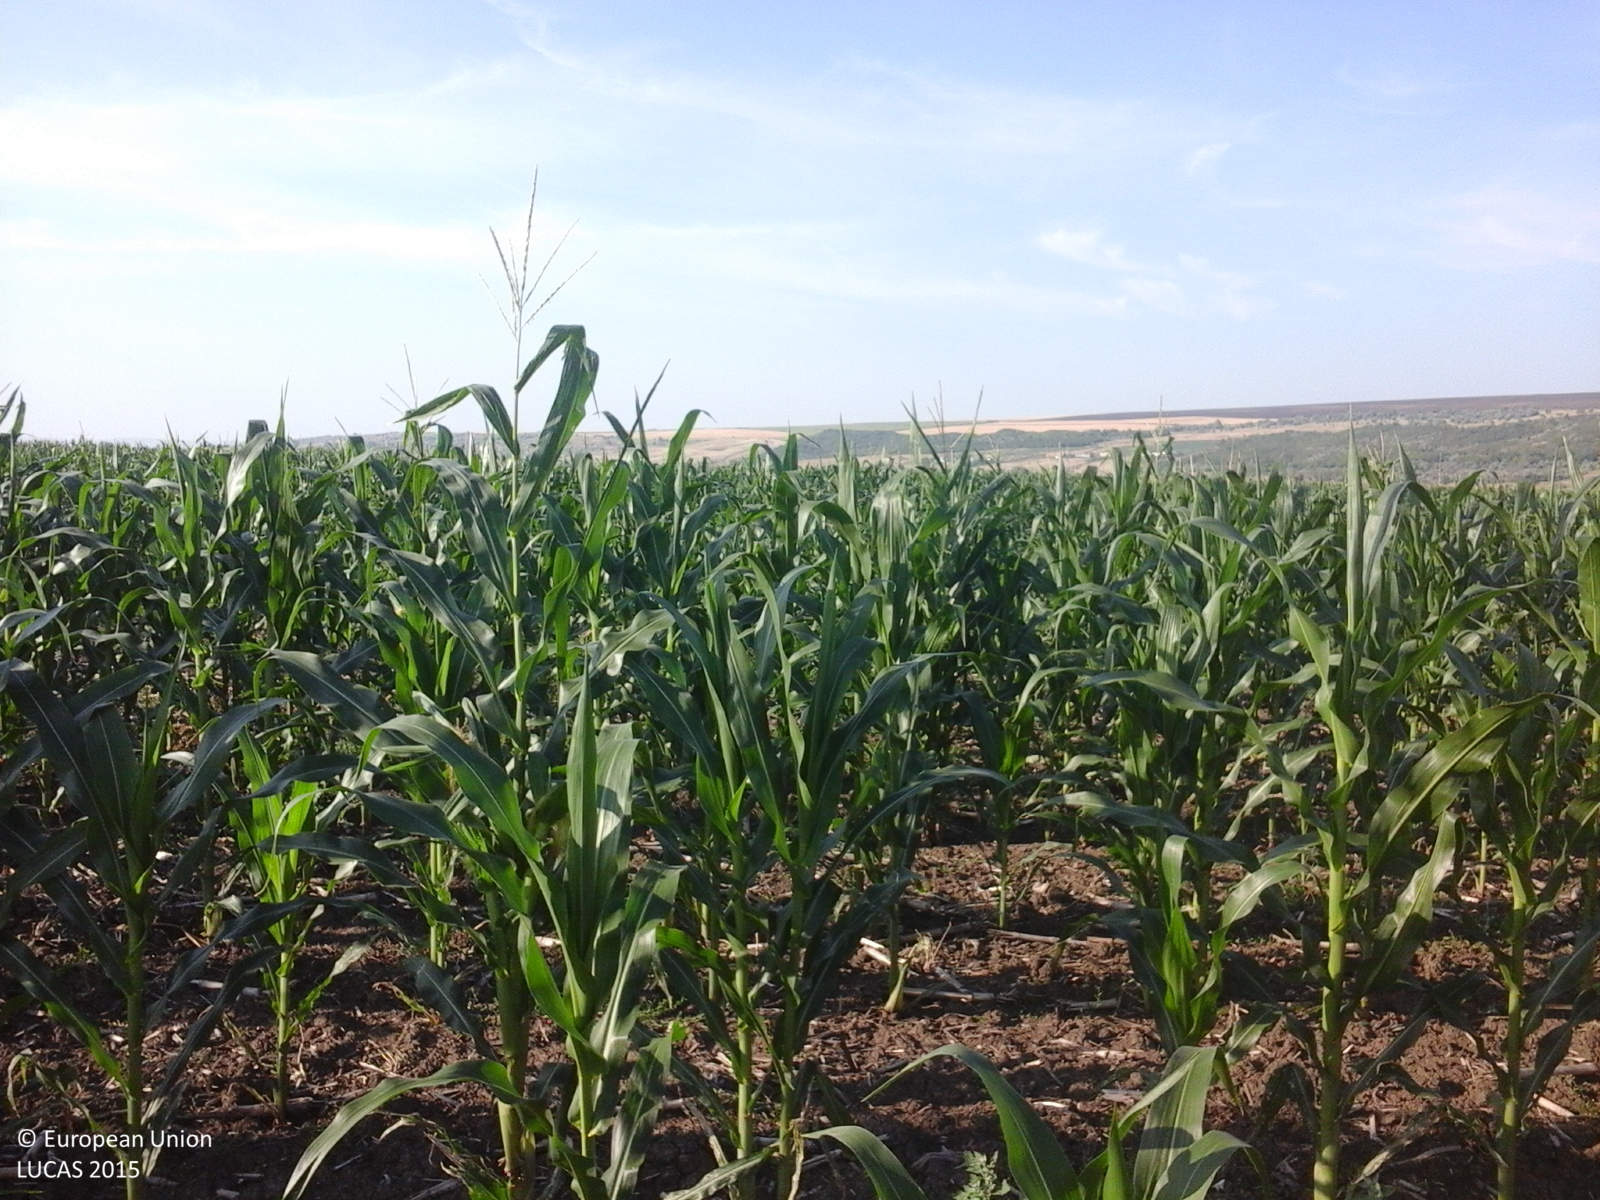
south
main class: Cropland
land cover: Maize
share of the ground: 50 - 75 %
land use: Agriculture (excluding fallow land and kitchen gardens)
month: July
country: RO
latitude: 46.5096
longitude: 28.1825
